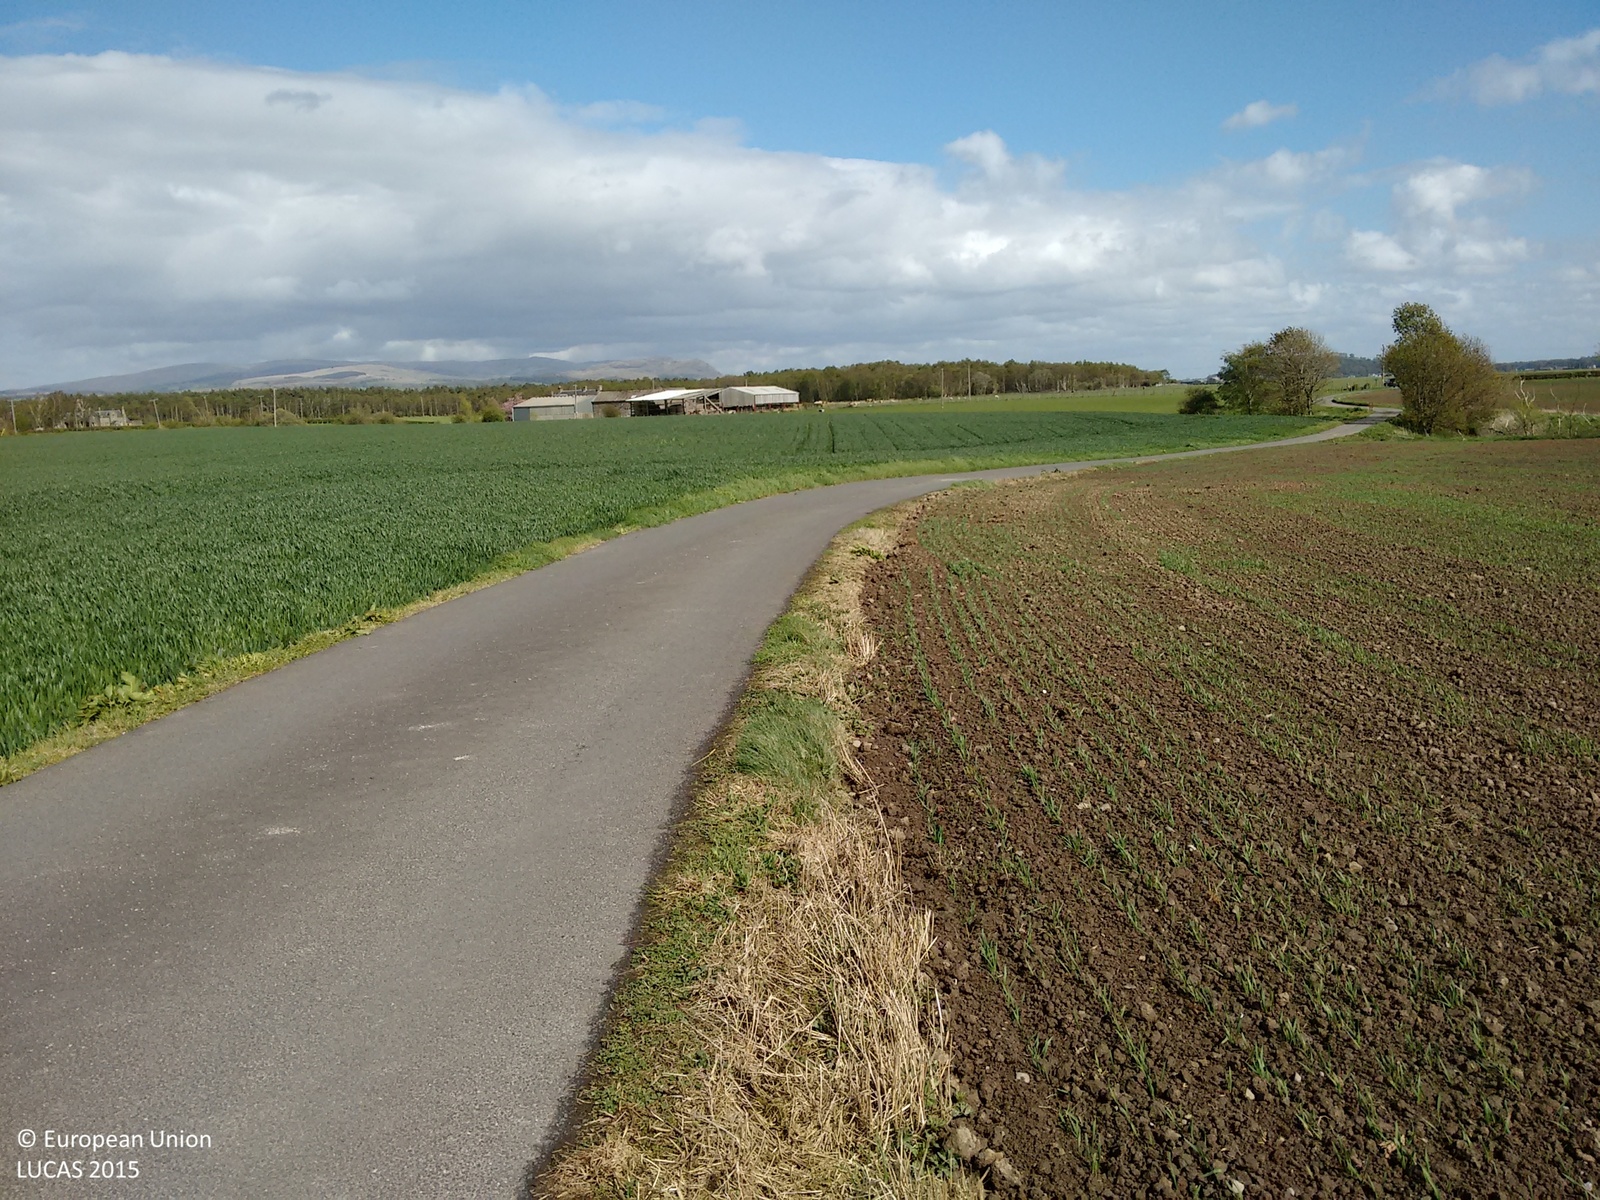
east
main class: Cropland
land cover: Barley
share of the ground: 10 - 25 %
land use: Agriculture (excluding fallow land and kitchen gardens)
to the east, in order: Barley; Grass margins; Paved roads, cycling and walking lanes; Grass margins; Barley; Tracks; Grass margins; Rivers and streams; Grassland without tree/shrub cover; Electric lines; Grassland without tree/shrub cover
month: May
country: GB
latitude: 56.1418
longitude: -4.0408
